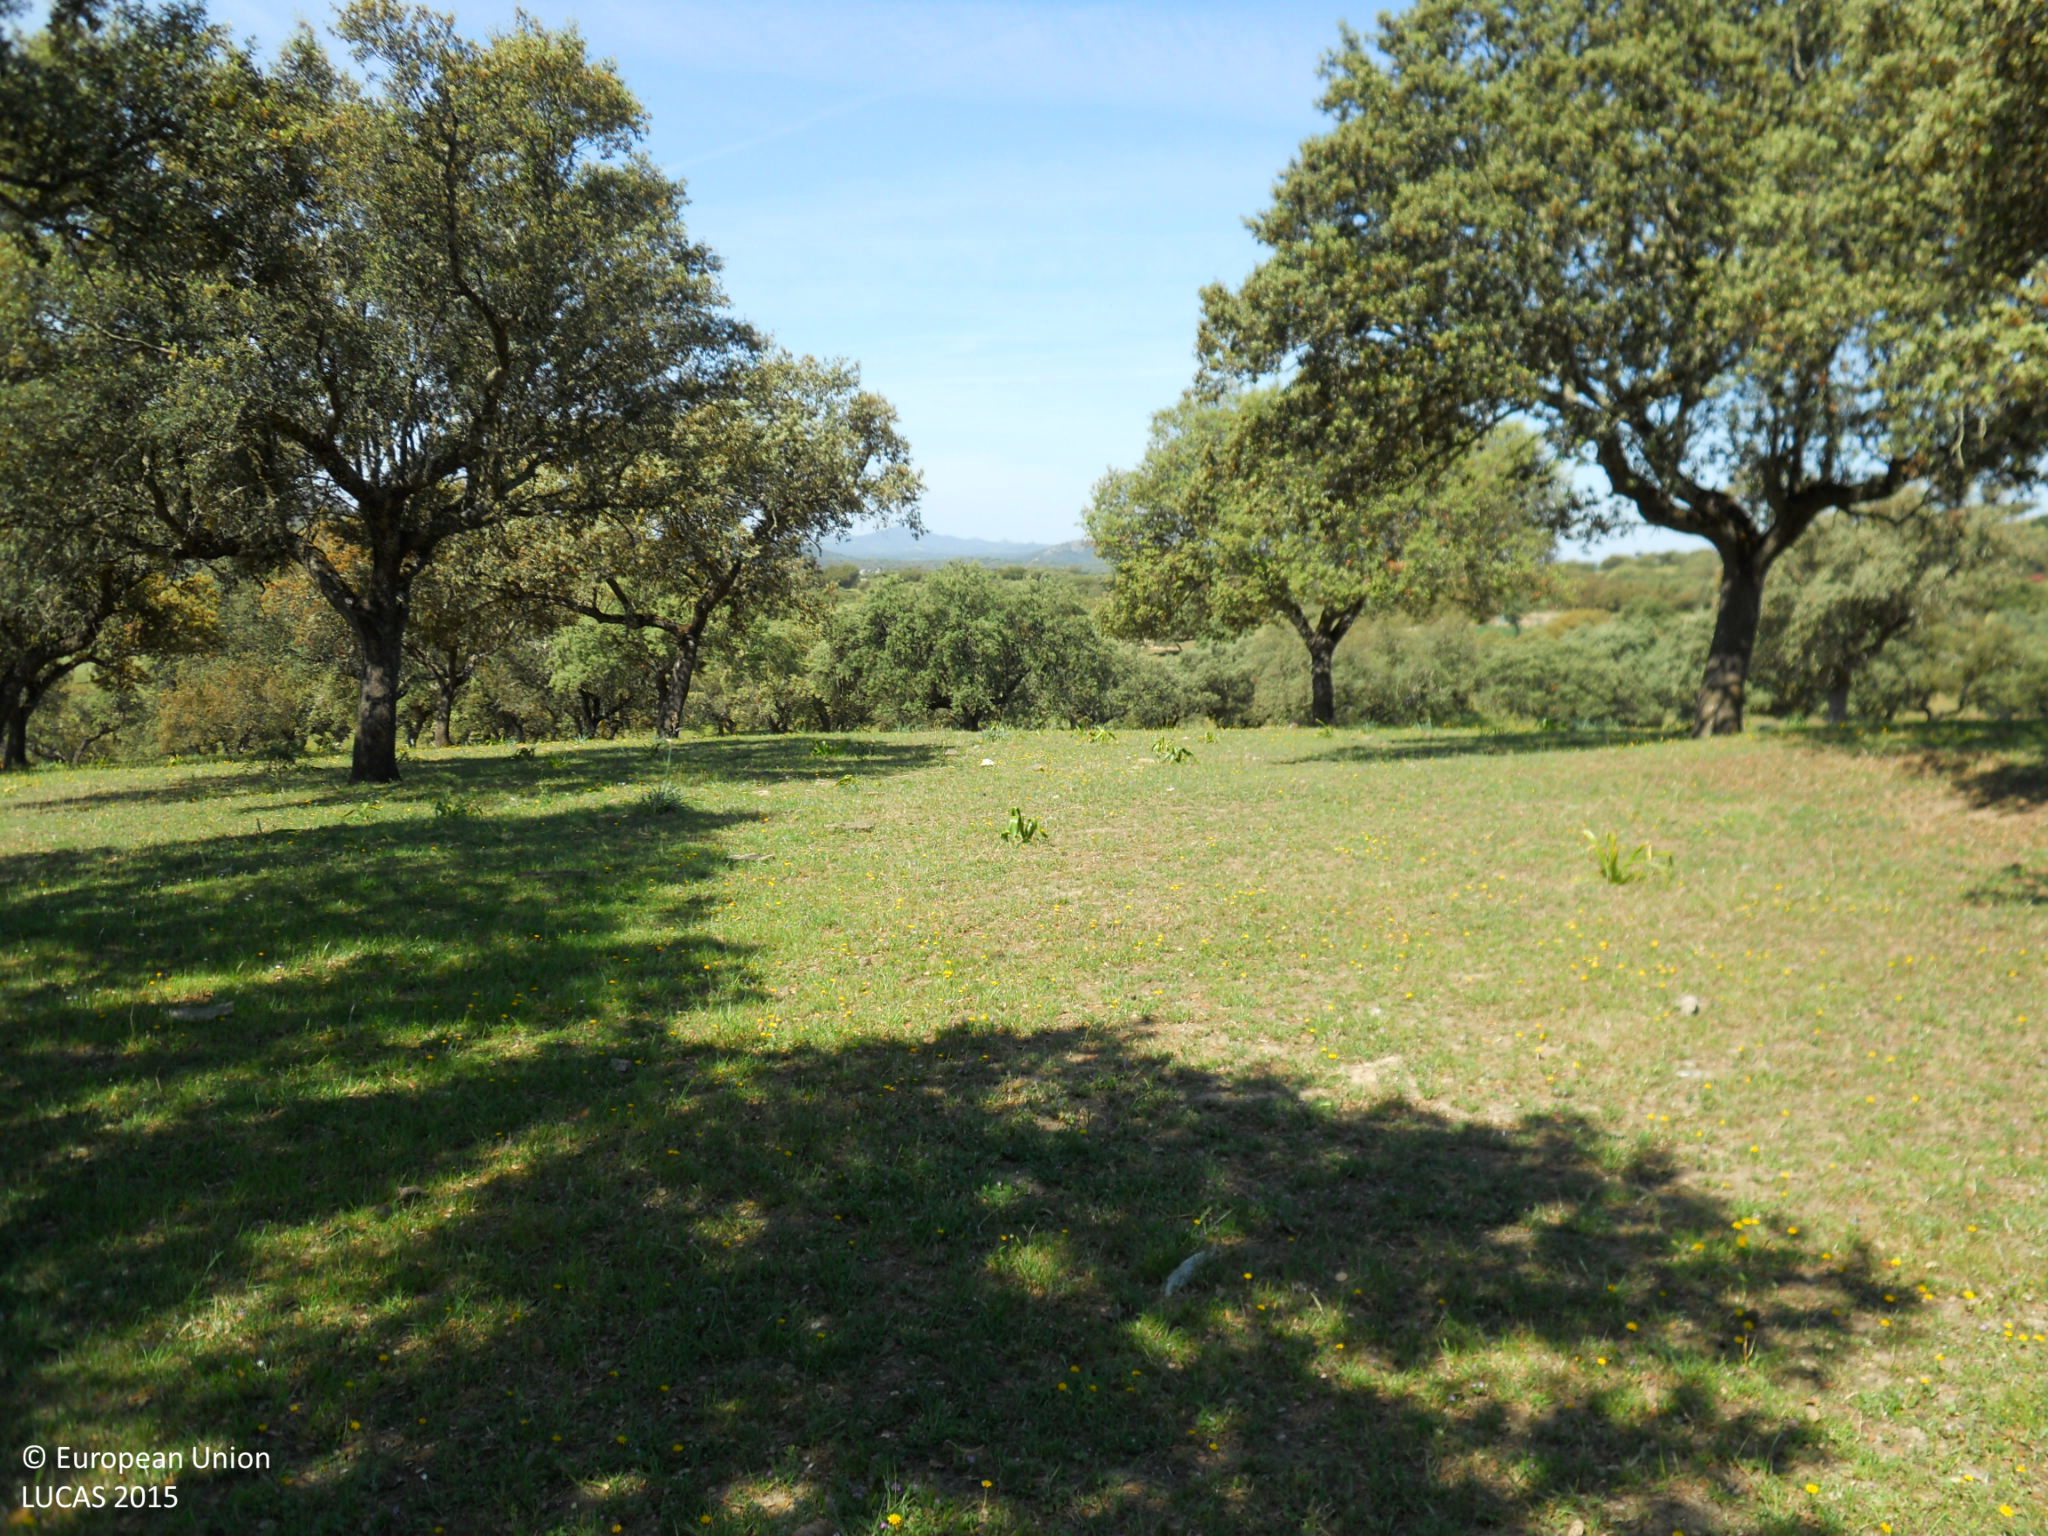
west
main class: Woodland
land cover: Broadleaved woodland
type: broadleaved evergreen forest
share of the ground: > 75 %
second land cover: Grassland without tree/shrub cover
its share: > 75 %
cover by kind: broadleaved forest trees 90 %, herbaceous plants 10 %
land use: Forestry
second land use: Agriculture (excluding fallow land and kitchen gardens)
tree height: > 5 m
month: April
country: ES
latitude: 39.2192
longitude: -6.7619
